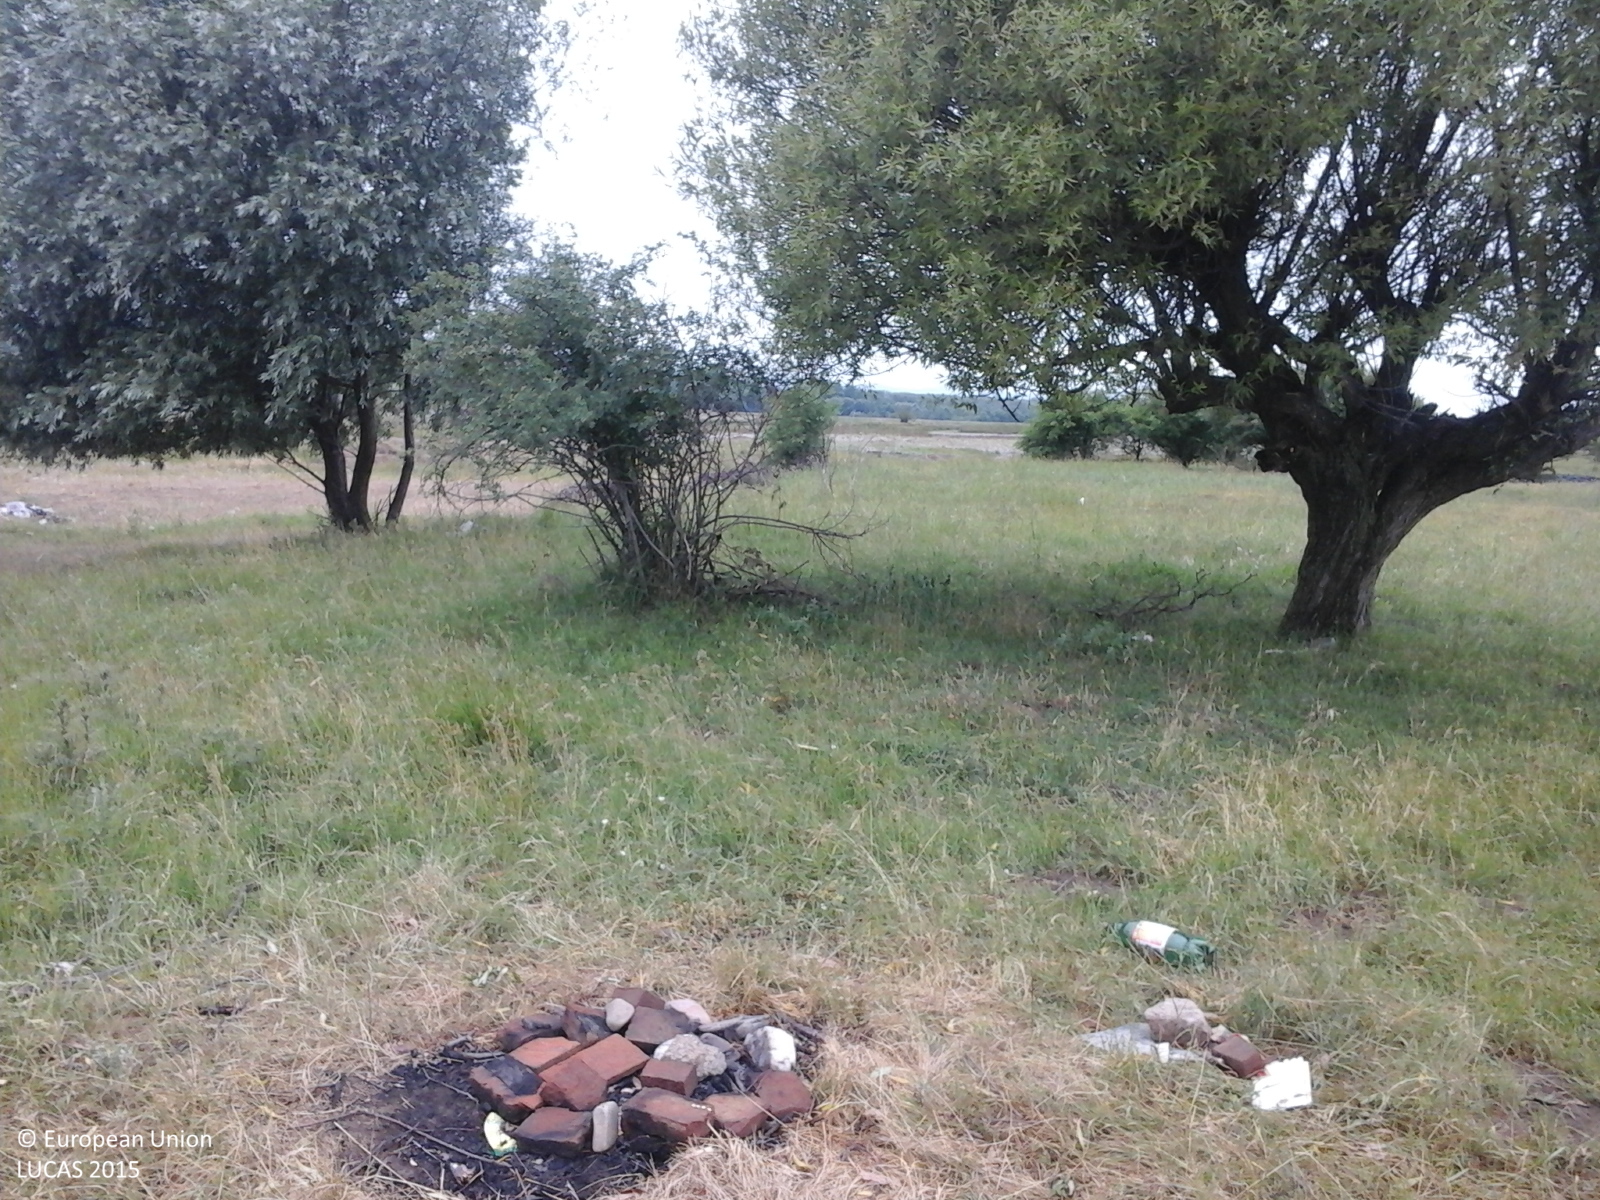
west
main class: Grassland
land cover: Grassland with sparse tree/shrub cover
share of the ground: > 75 %
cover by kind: herbaceous plants 90 %, broadleaved forest trees 5 %, shrubs 5 %
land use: Agriculture (excluding fallow land and kitchen gardens)
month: June
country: RO
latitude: 47.4421
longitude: 26.1647
